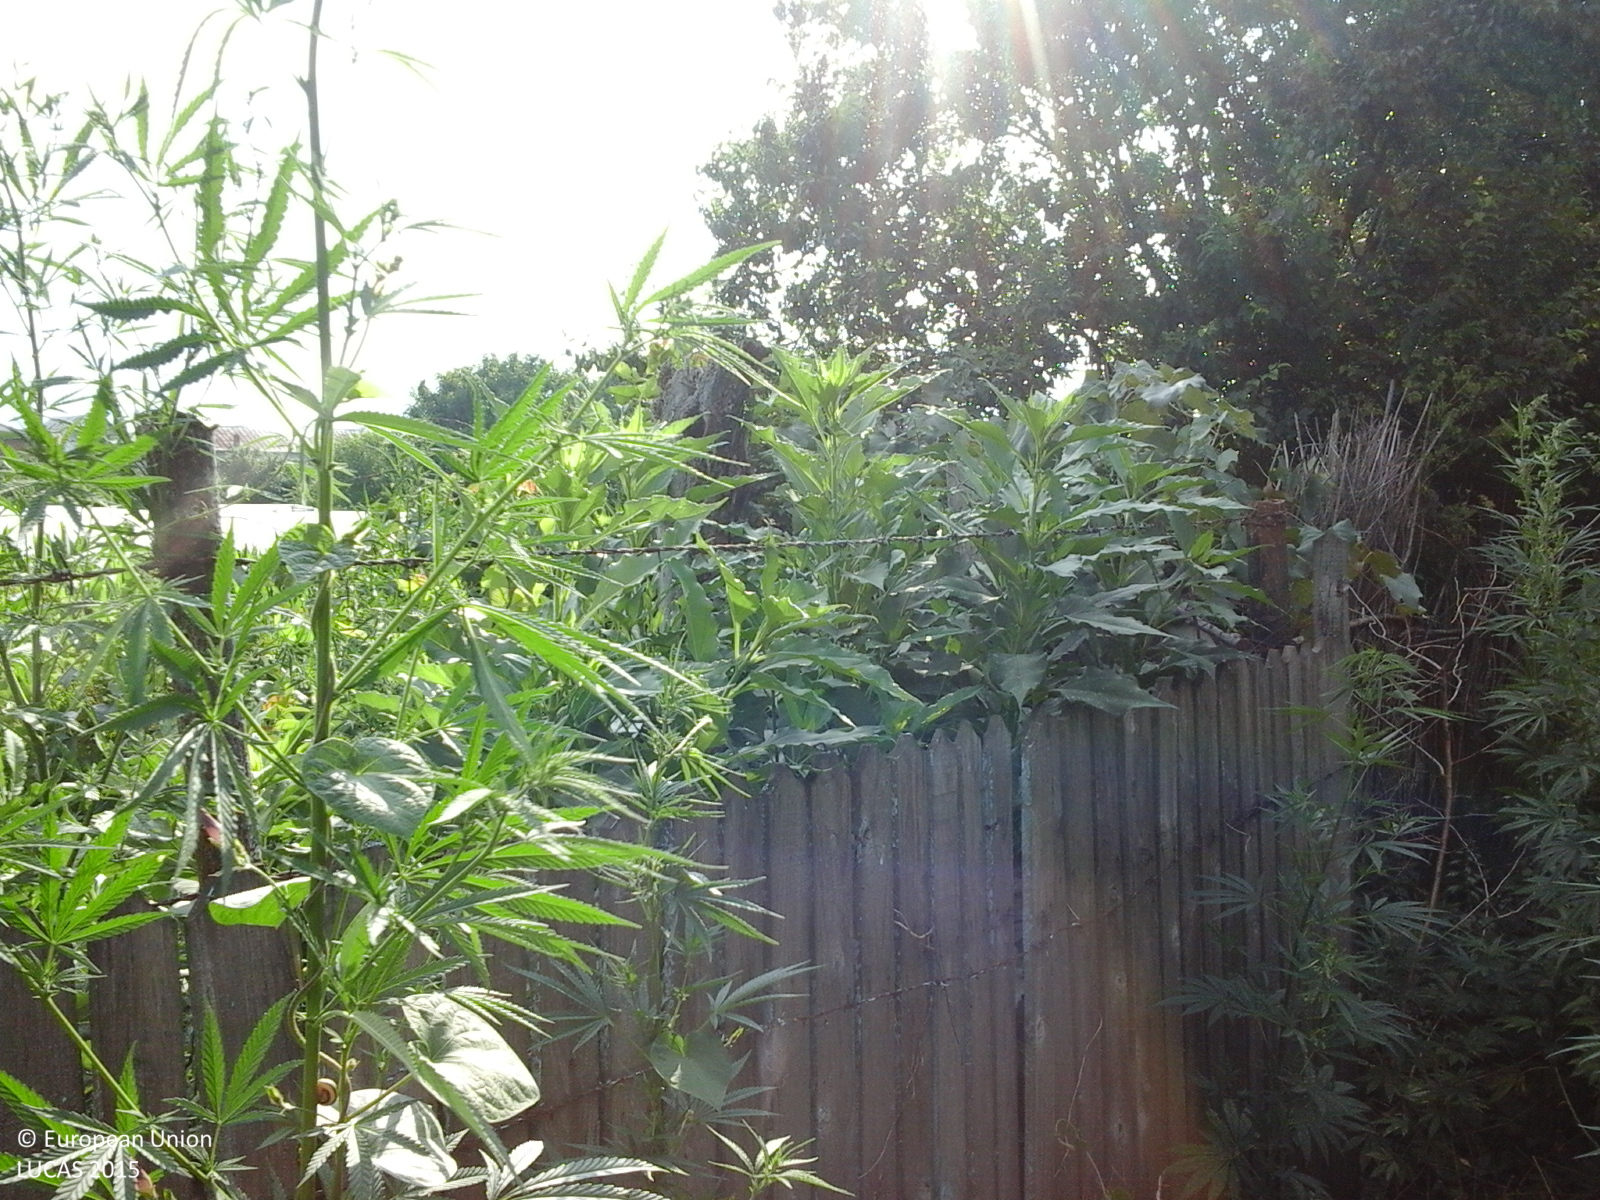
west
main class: Cropland
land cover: Maize
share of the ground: > 75 %
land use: Agriculture (excluding fallow land and kitchen gardens)
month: June
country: RO
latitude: 44.3116
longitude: 26.1134
